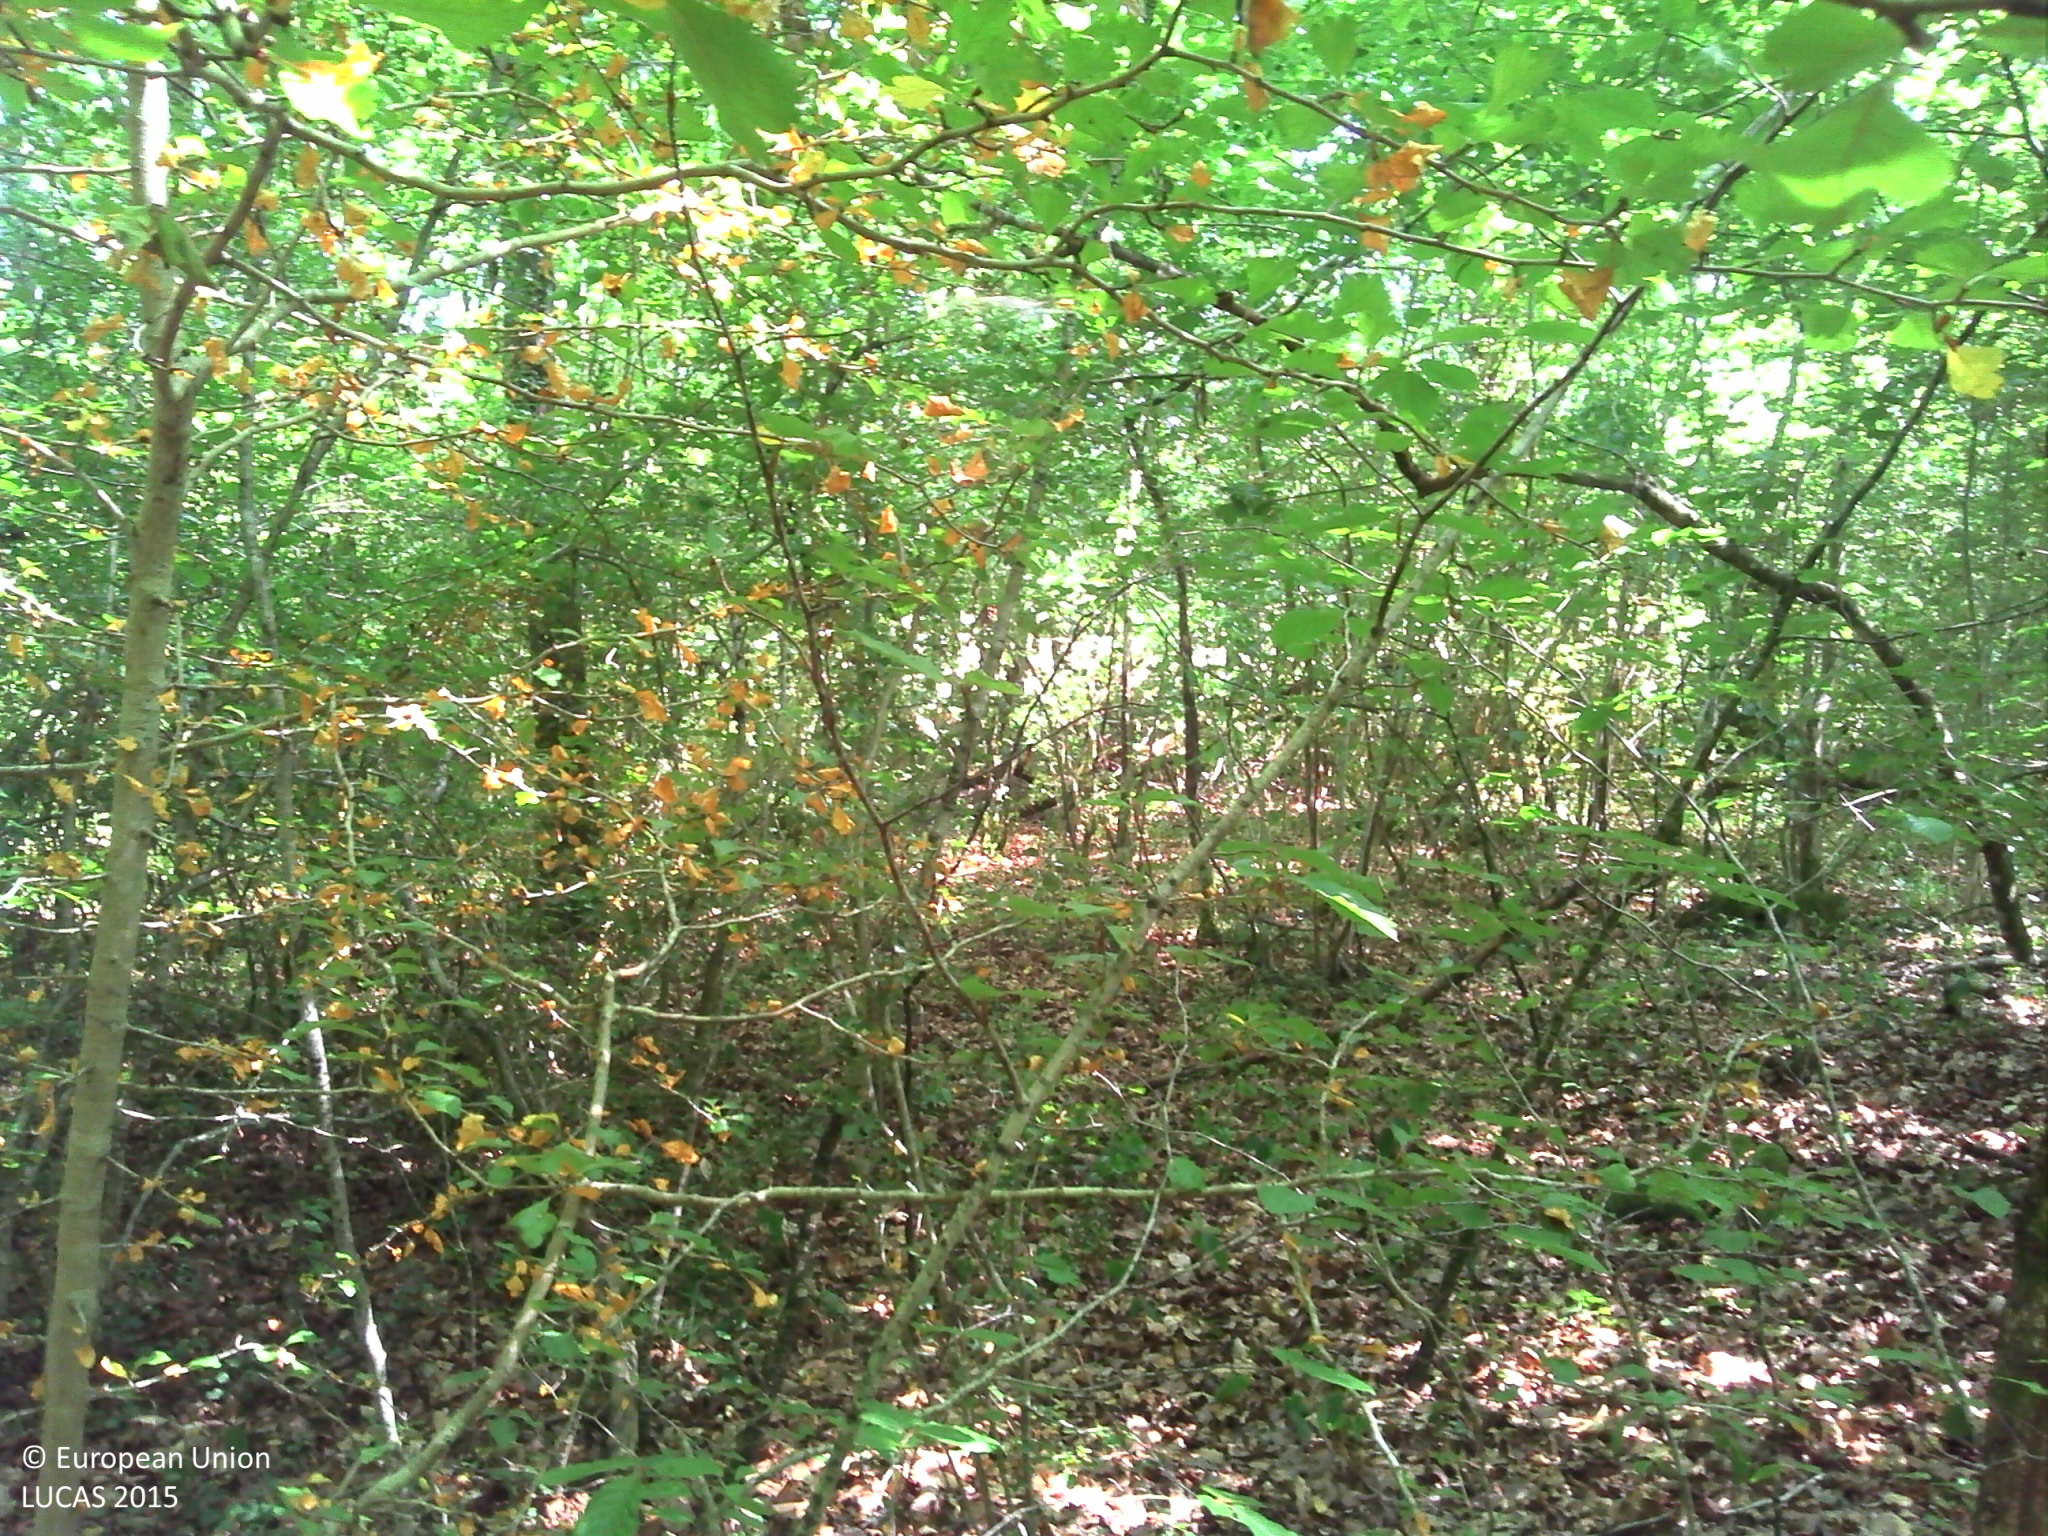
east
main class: Woodland
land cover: Broadleaved woodland
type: acidophilous oak and oak-birch forest
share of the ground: > 75 %
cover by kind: broadleaved forest trees 90 %, herbaceous plants 5 %, lichens and mosses 5 %
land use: Forestry
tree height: > 5 m
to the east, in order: Broadleaved woodland; Grassland without tree/shrub cover; Barley
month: July
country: FR
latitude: 48.0254
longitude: 4.7288
